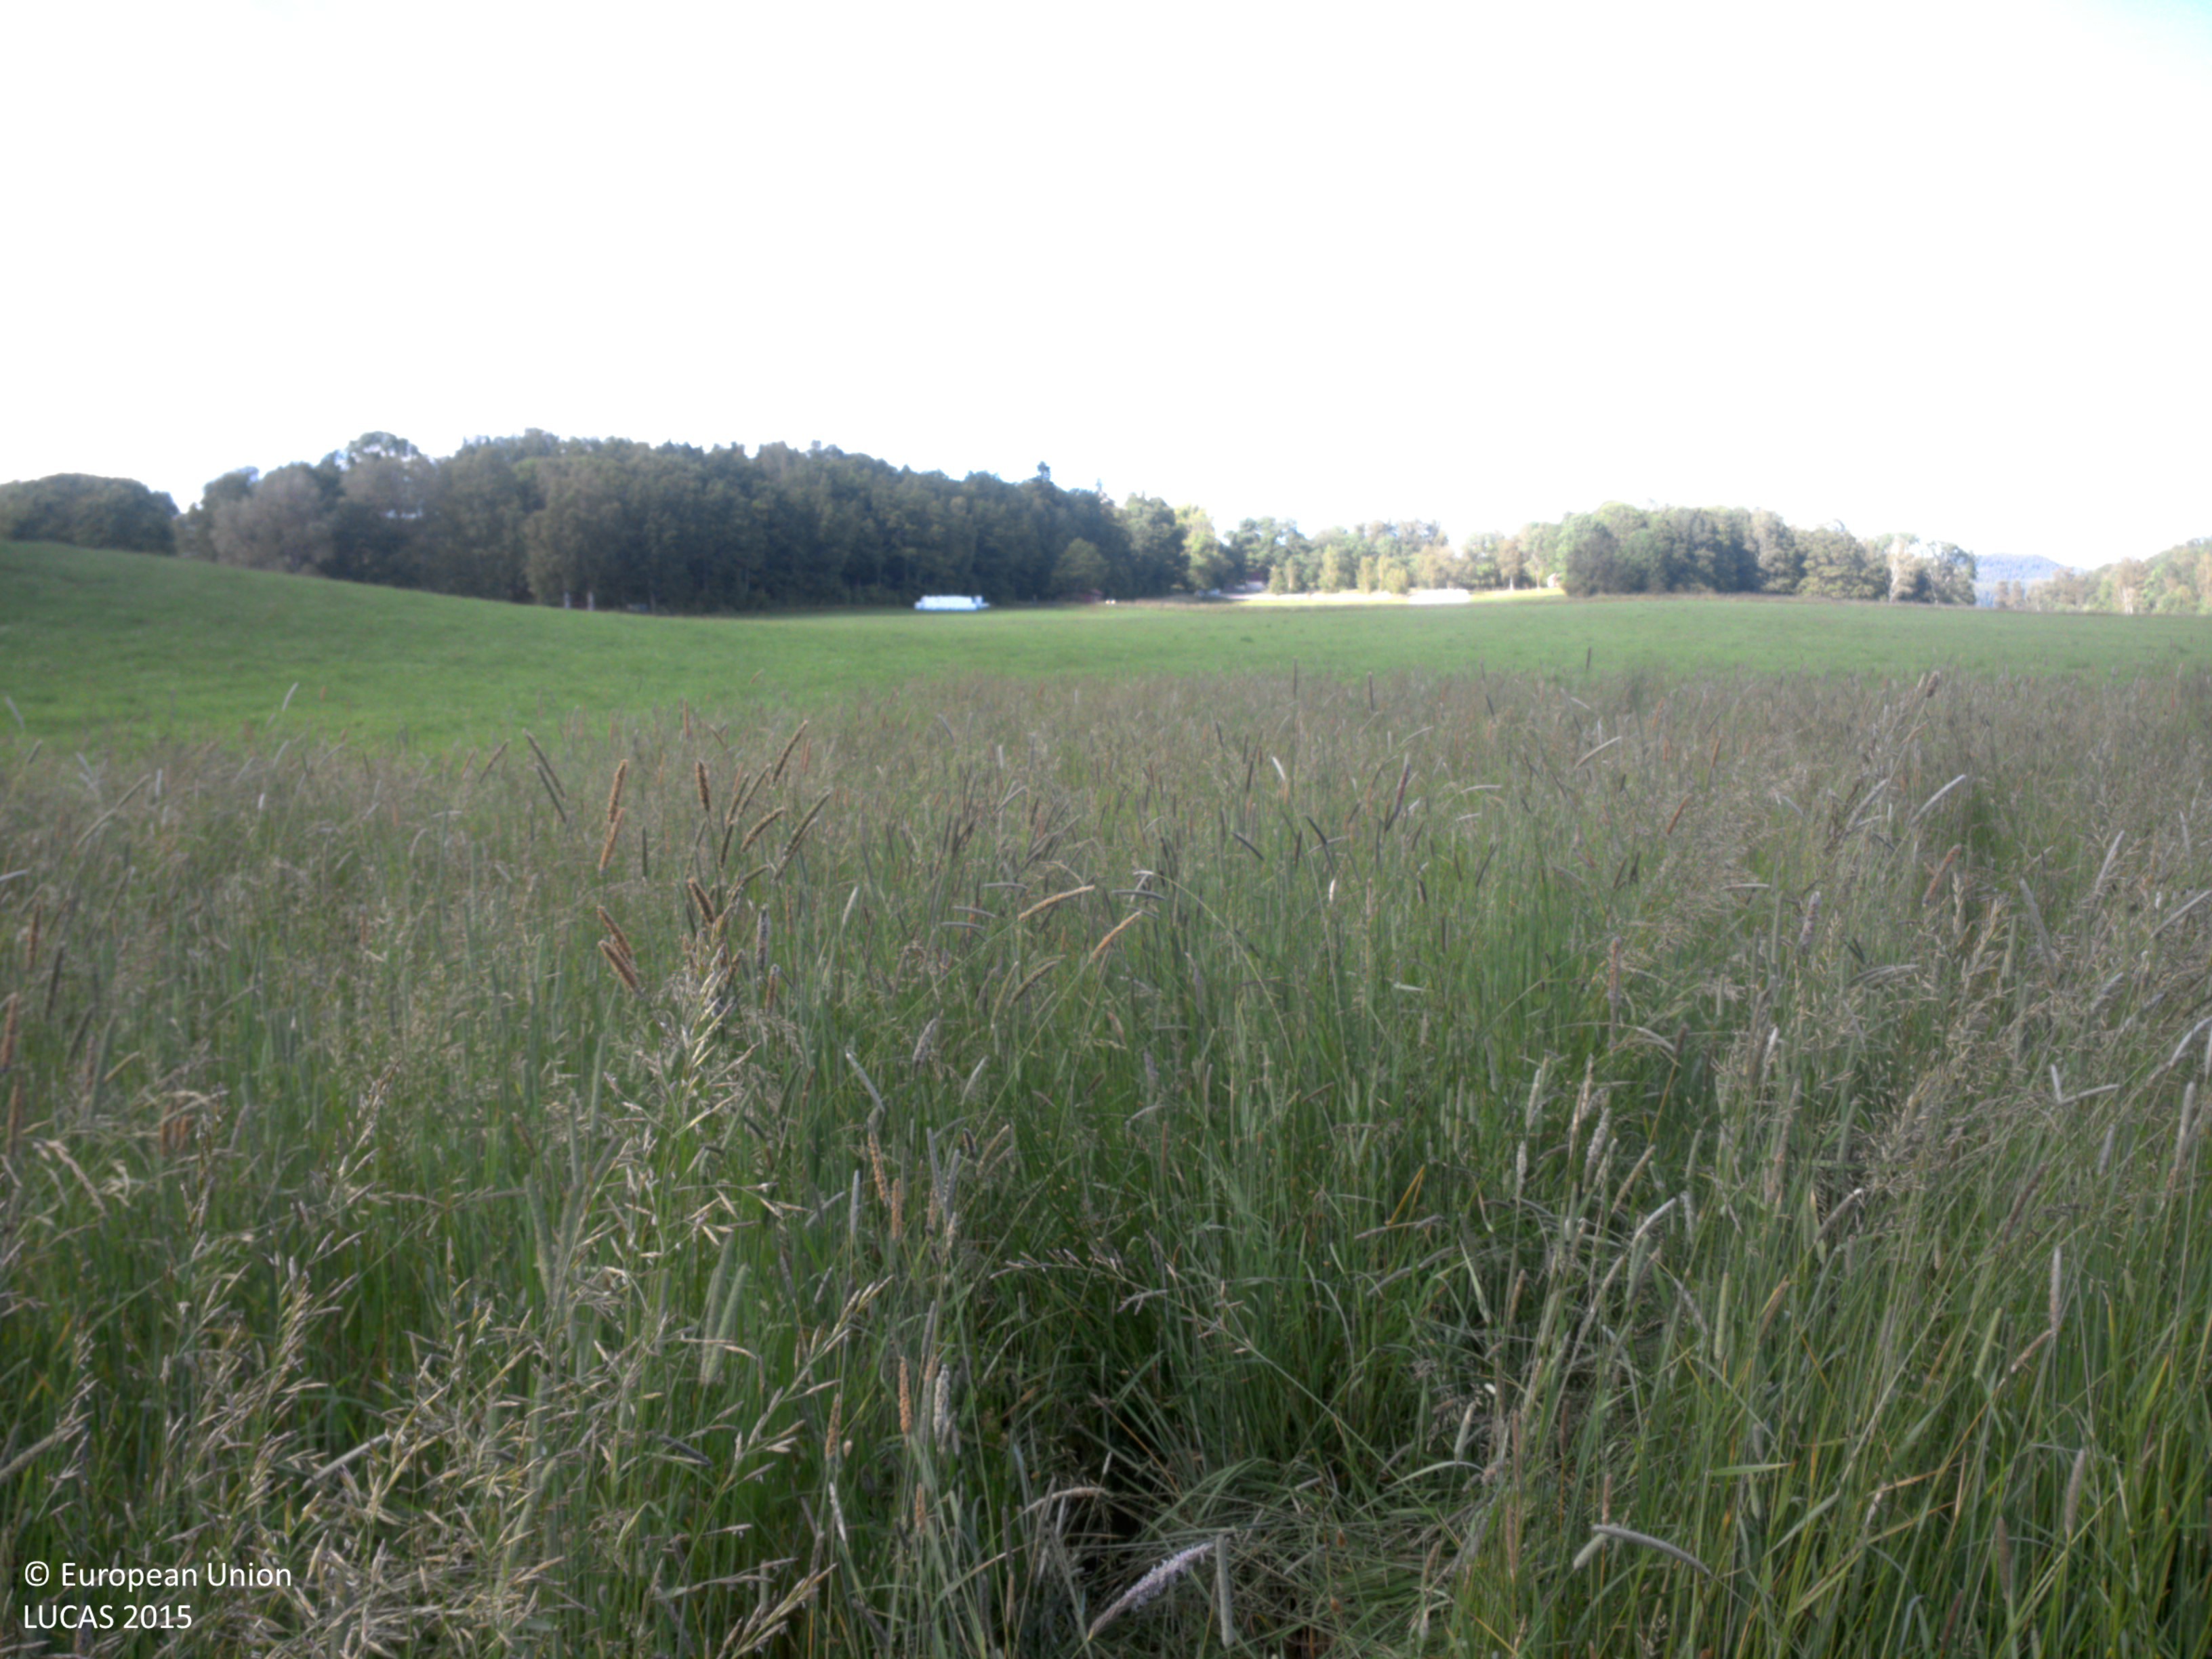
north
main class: Cropland
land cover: Mixed cereals for fodder
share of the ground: > 75 %
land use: Agriculture (excluding fallow land and kitchen gardens)
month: June
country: SE
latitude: 58.9561
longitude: 12.2723
